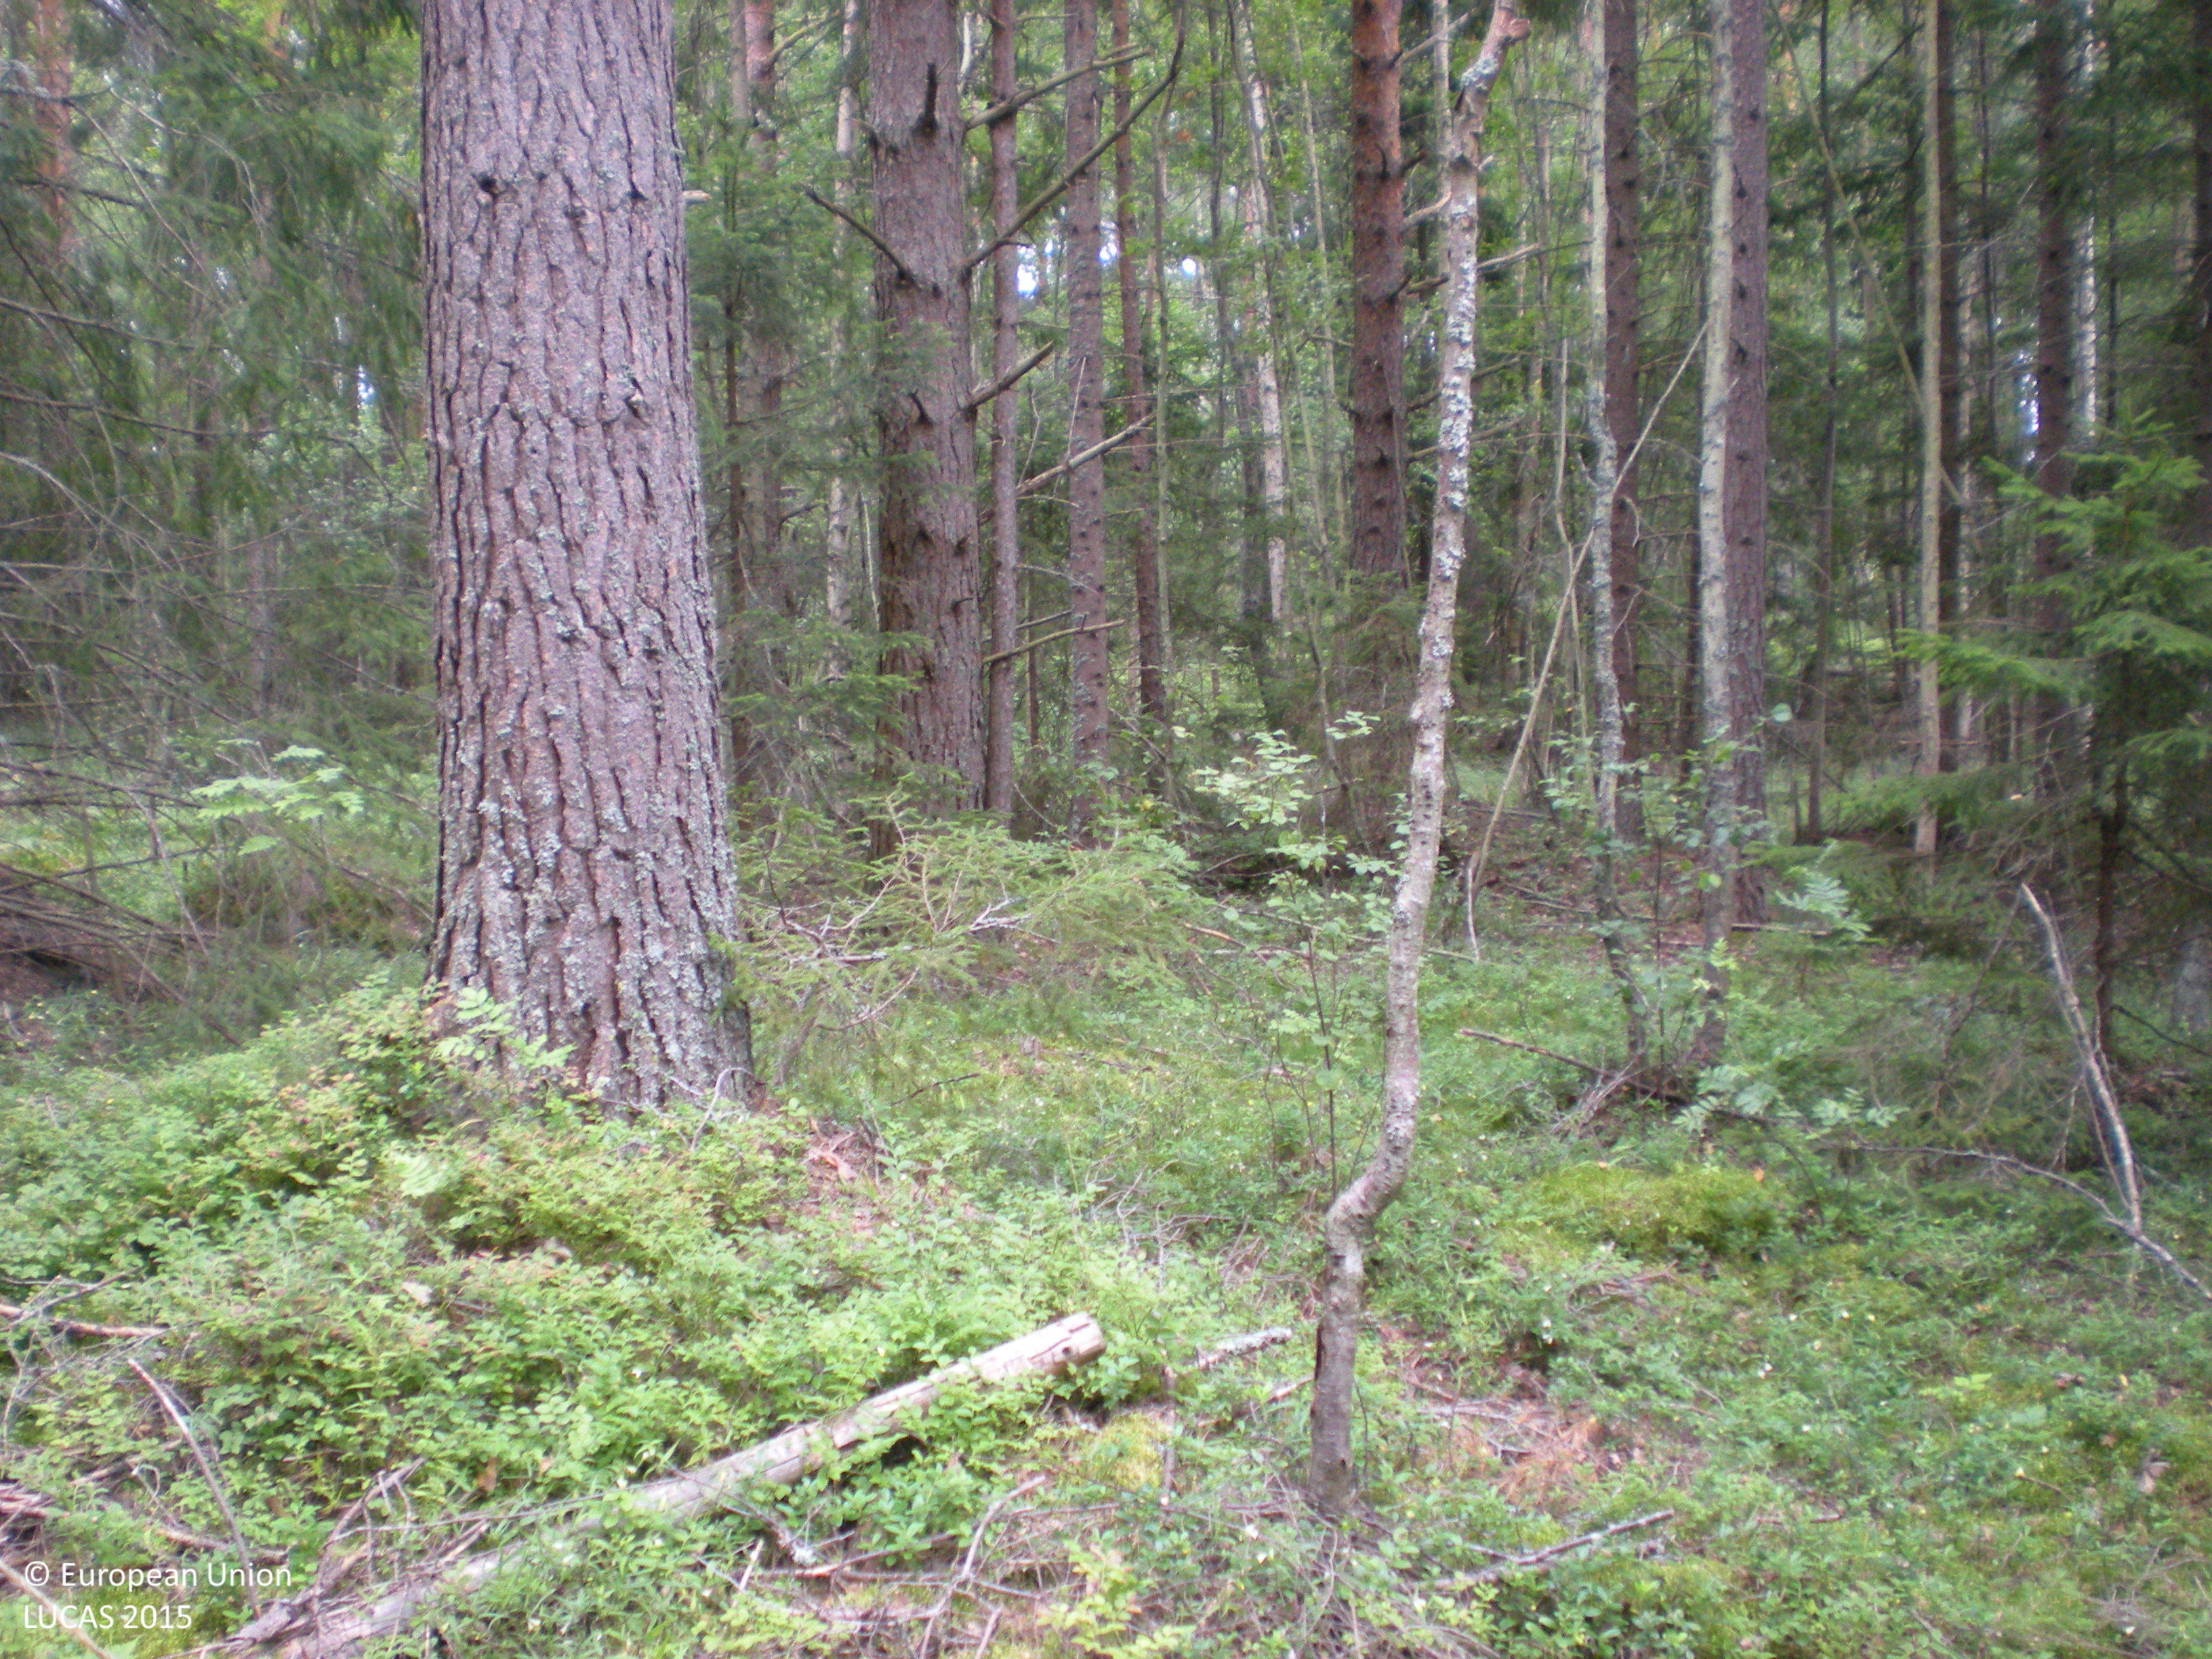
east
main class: Woodland
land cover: Pine dominated coniferous woodland
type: boreal forest
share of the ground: 50 - 75 %
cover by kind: coniferous forest trees 65 %, herbaceous plants 20 %, shrubs 10 %, lichens and mosses 5 %
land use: Forestry
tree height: > 5 m
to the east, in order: Pine dominated coniferous woodland; Other mixed woodland; Grassland with sparse tree/shrub cover; Pine dominated mixed woodland; Inland fresh water bodies
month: August
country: SE
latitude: 60.7904
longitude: 17.2449
